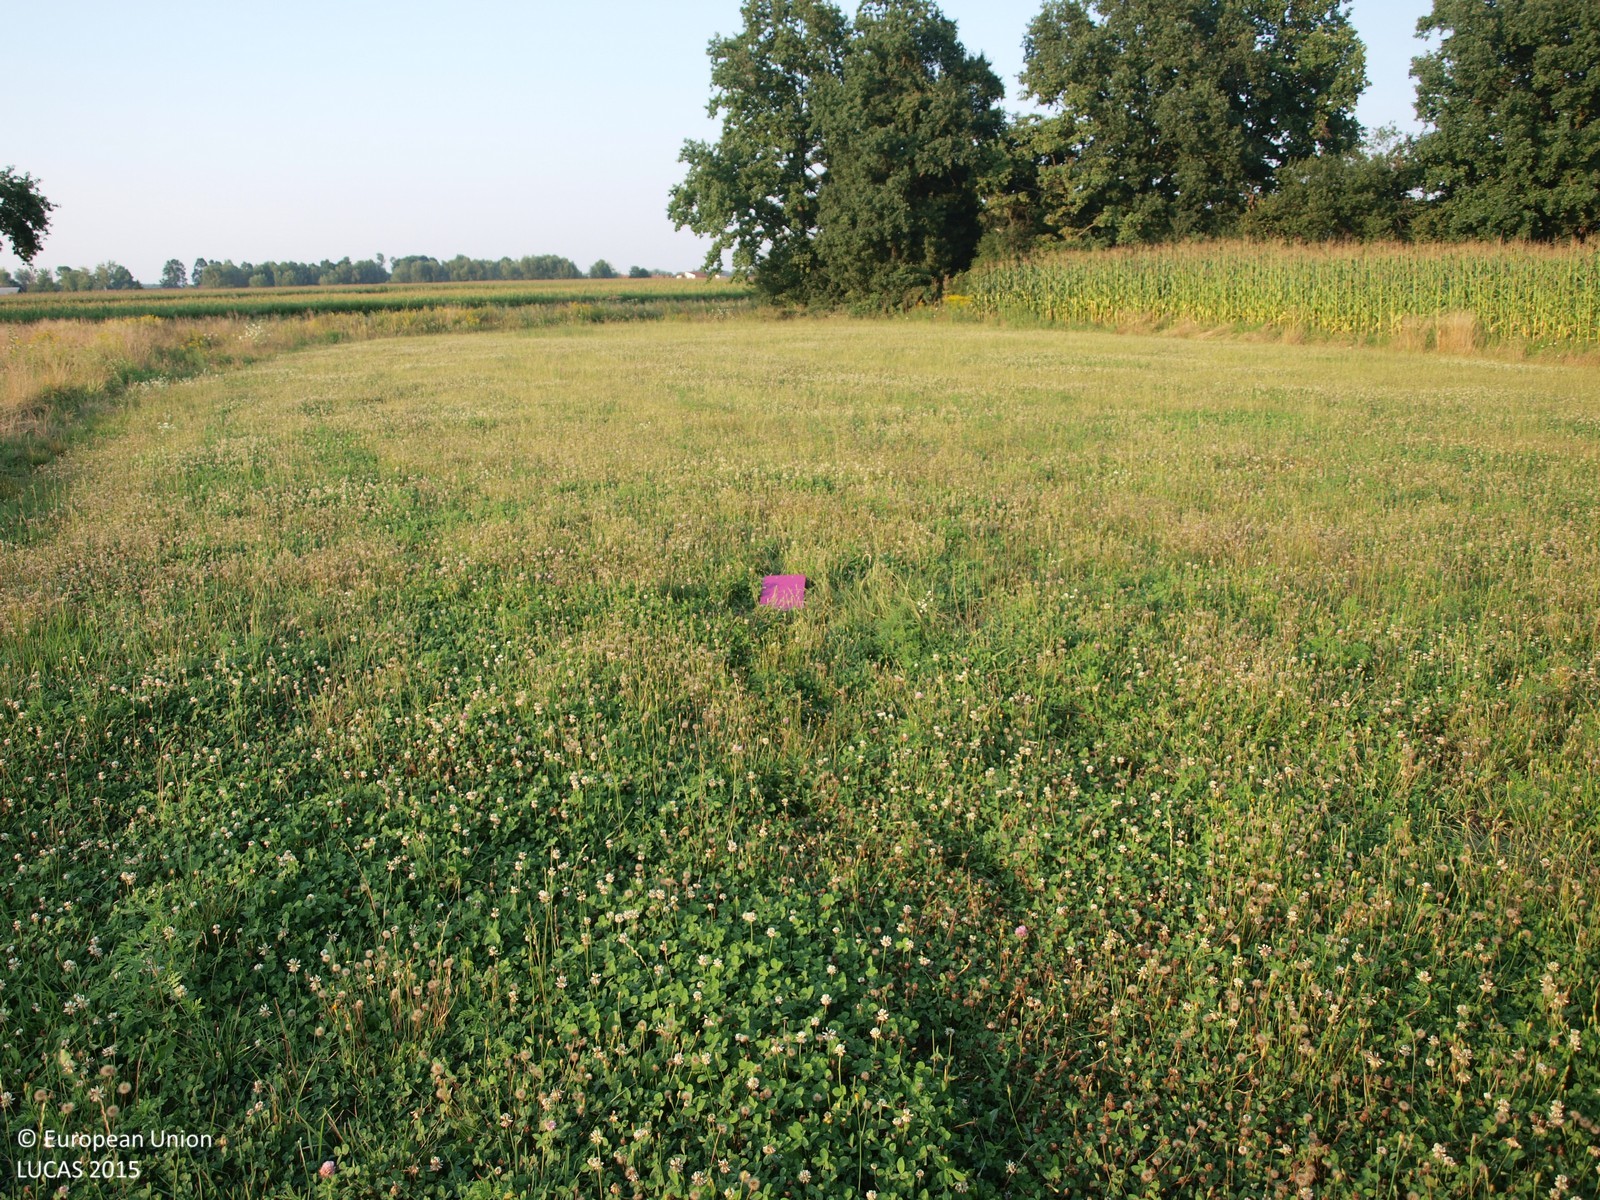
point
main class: Grassland
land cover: Grassland without tree/shrub cover
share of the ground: > 75 %
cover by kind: herbaceous plants 100 %
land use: Agriculture (excluding fallow land and kitchen gardens)
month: August
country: HR
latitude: 45.8282
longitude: 16.4999
